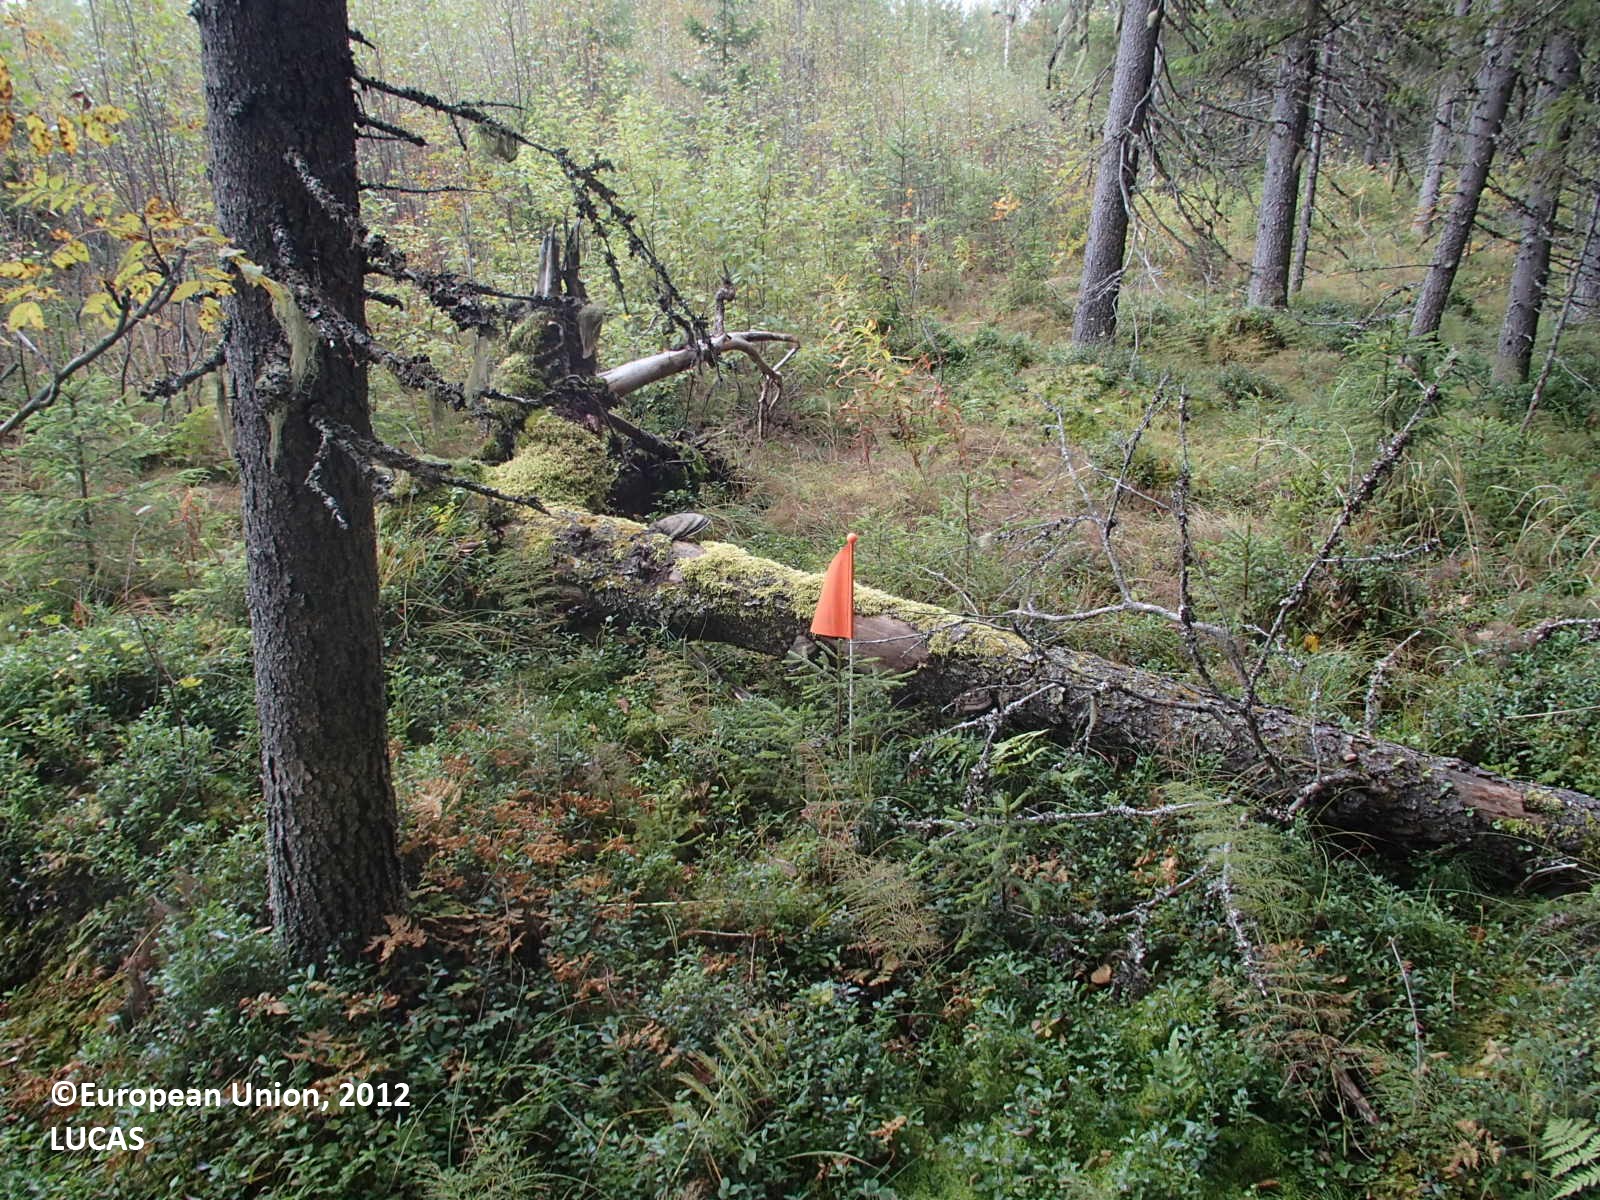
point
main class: Woodland
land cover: Spruce dominated mixed woodland
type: boreal forest
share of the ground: 50 - 75 %
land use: Forestry
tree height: > 5 m
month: September
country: FI
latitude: 63.8206
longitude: 27.1873
